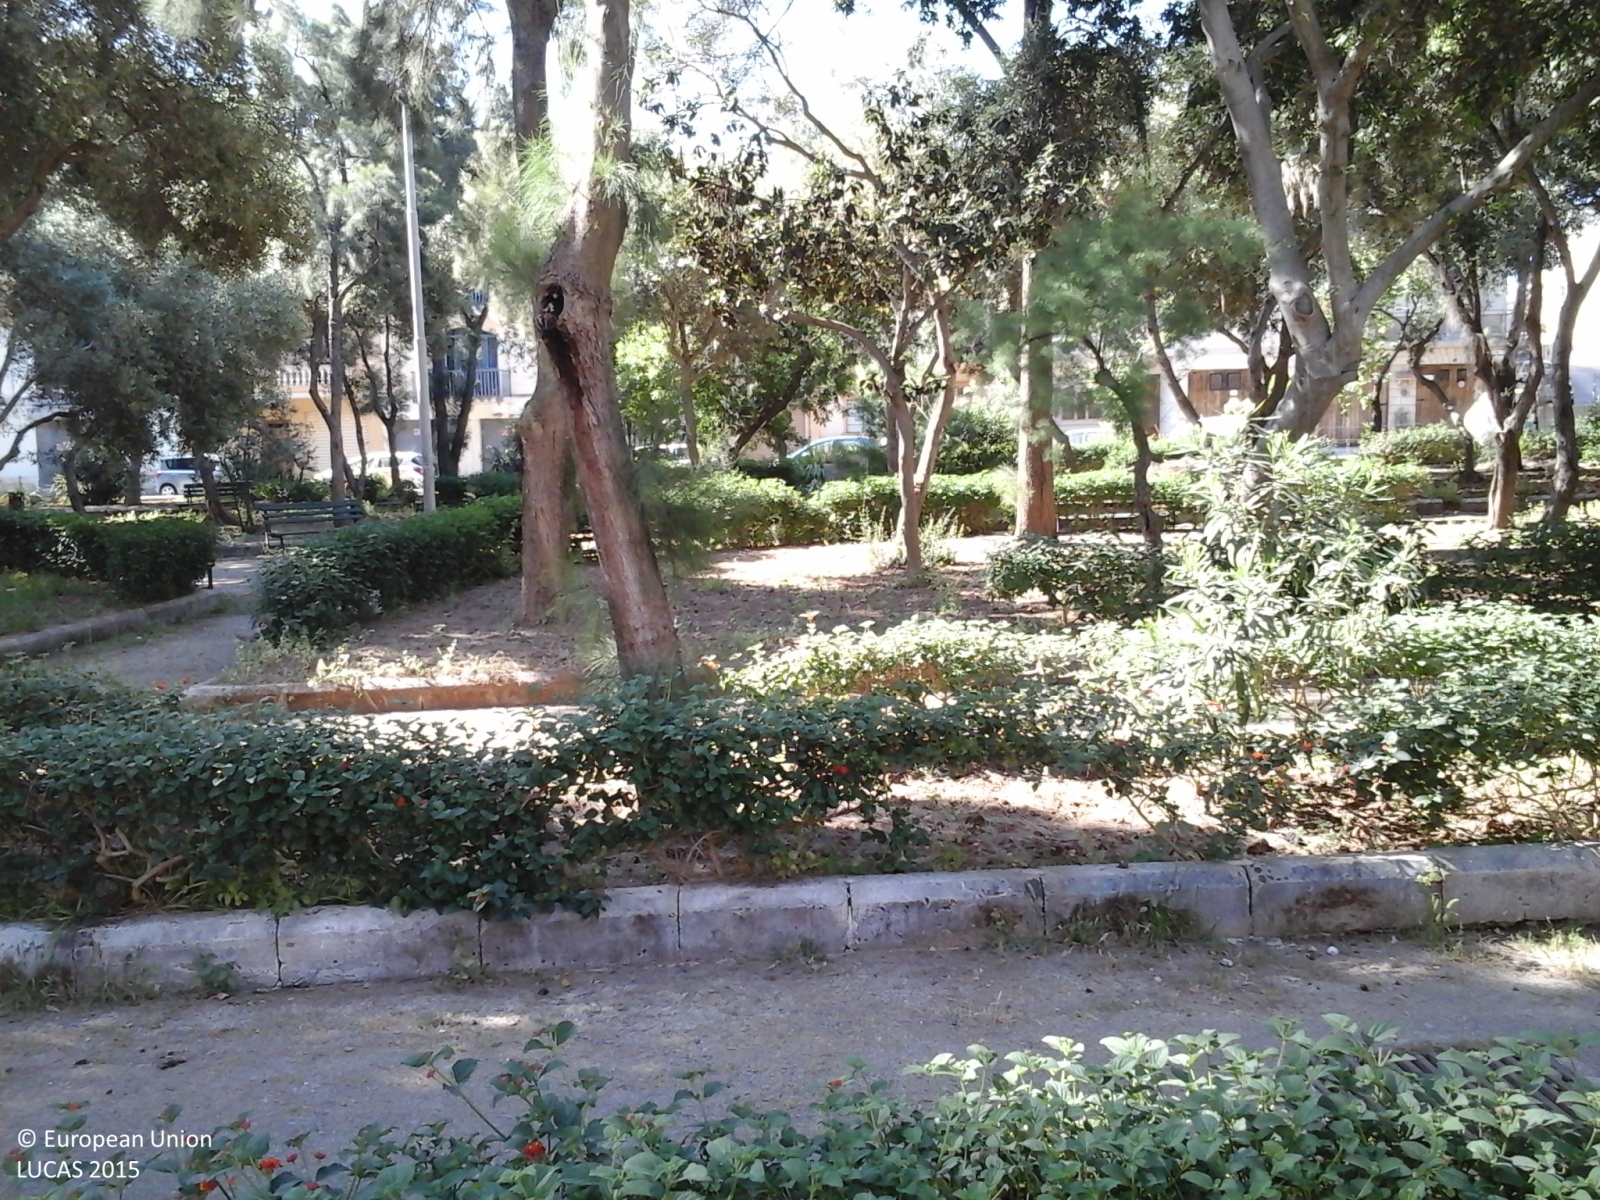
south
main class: Woodland
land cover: Pine dominated coniferous woodland
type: coniferous forest of the mediterranean region
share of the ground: 50 - 75 %
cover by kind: coniferous forest trees 100 %
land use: Amenities, museums, leisure
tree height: > 5 m
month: May
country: MT
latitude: 35.8753
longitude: 14.5105
